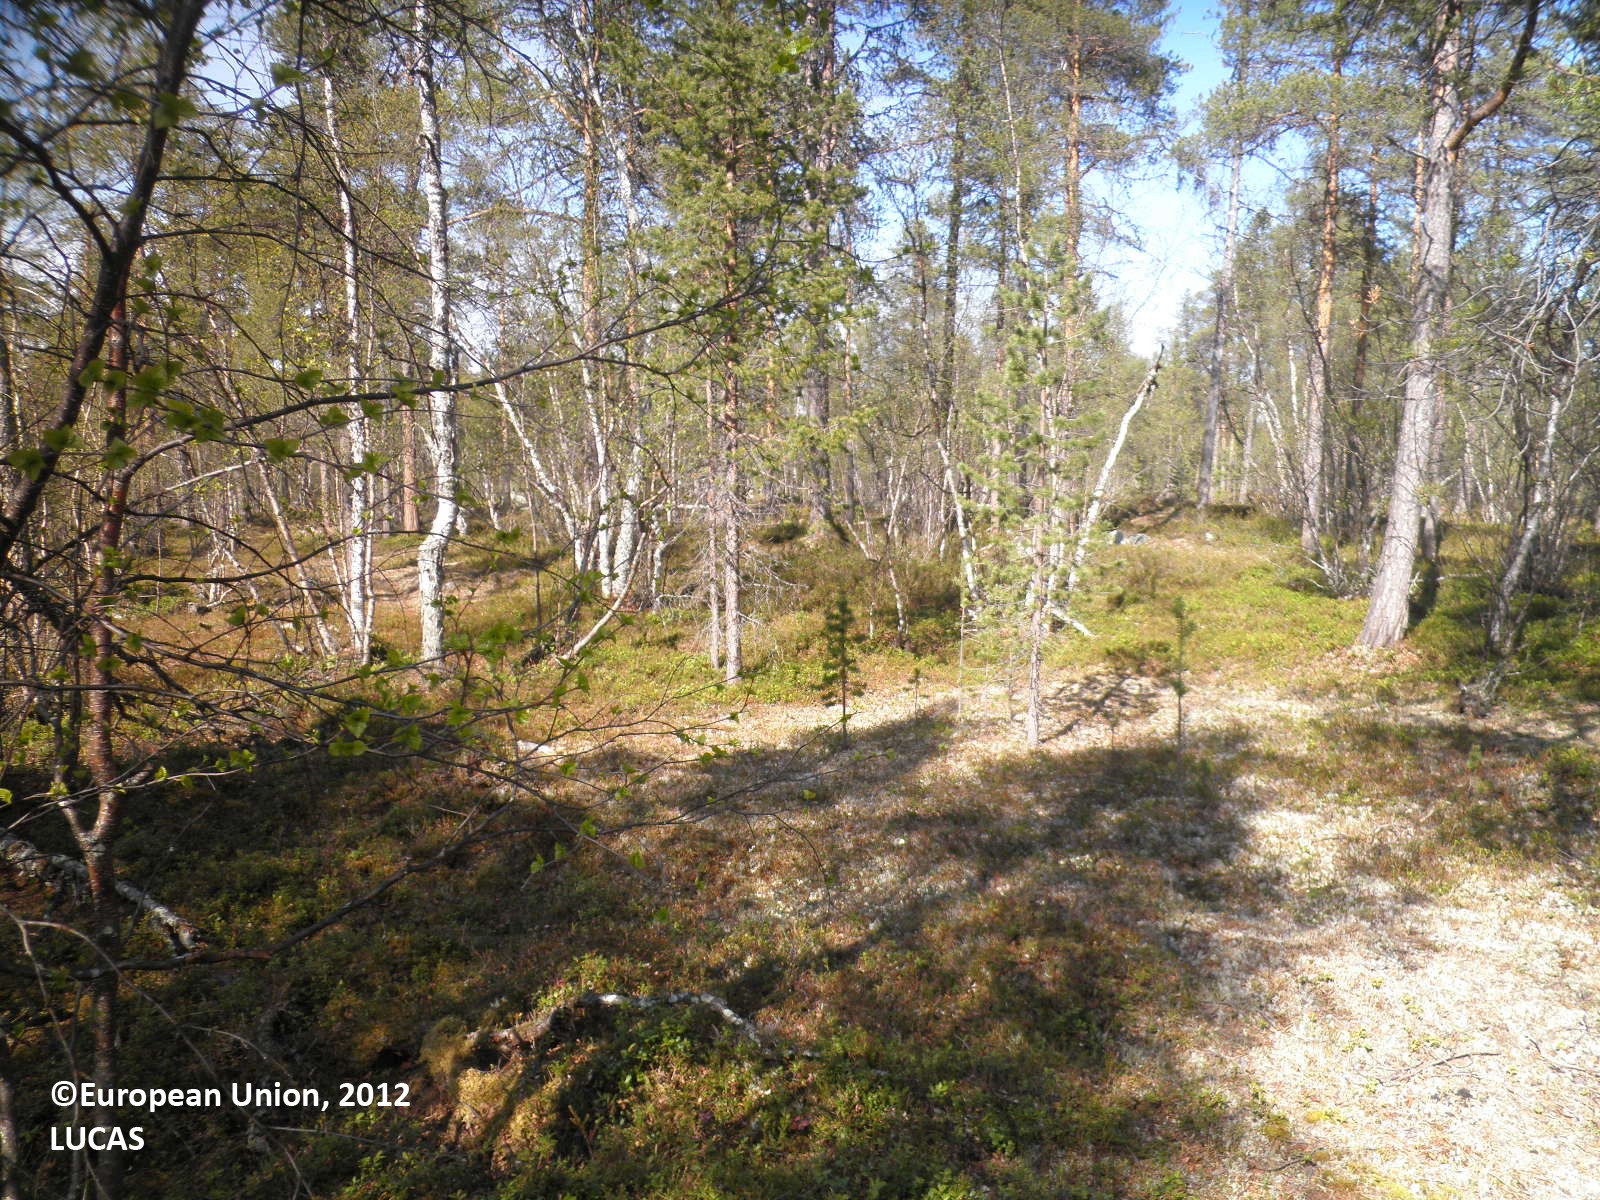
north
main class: Woodland
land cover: Pine dominated mixed woodland
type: boreal forest
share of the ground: > 75 %
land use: Forestry
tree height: > 5 m
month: June
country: FI
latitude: 69.4923
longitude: 28.5849
